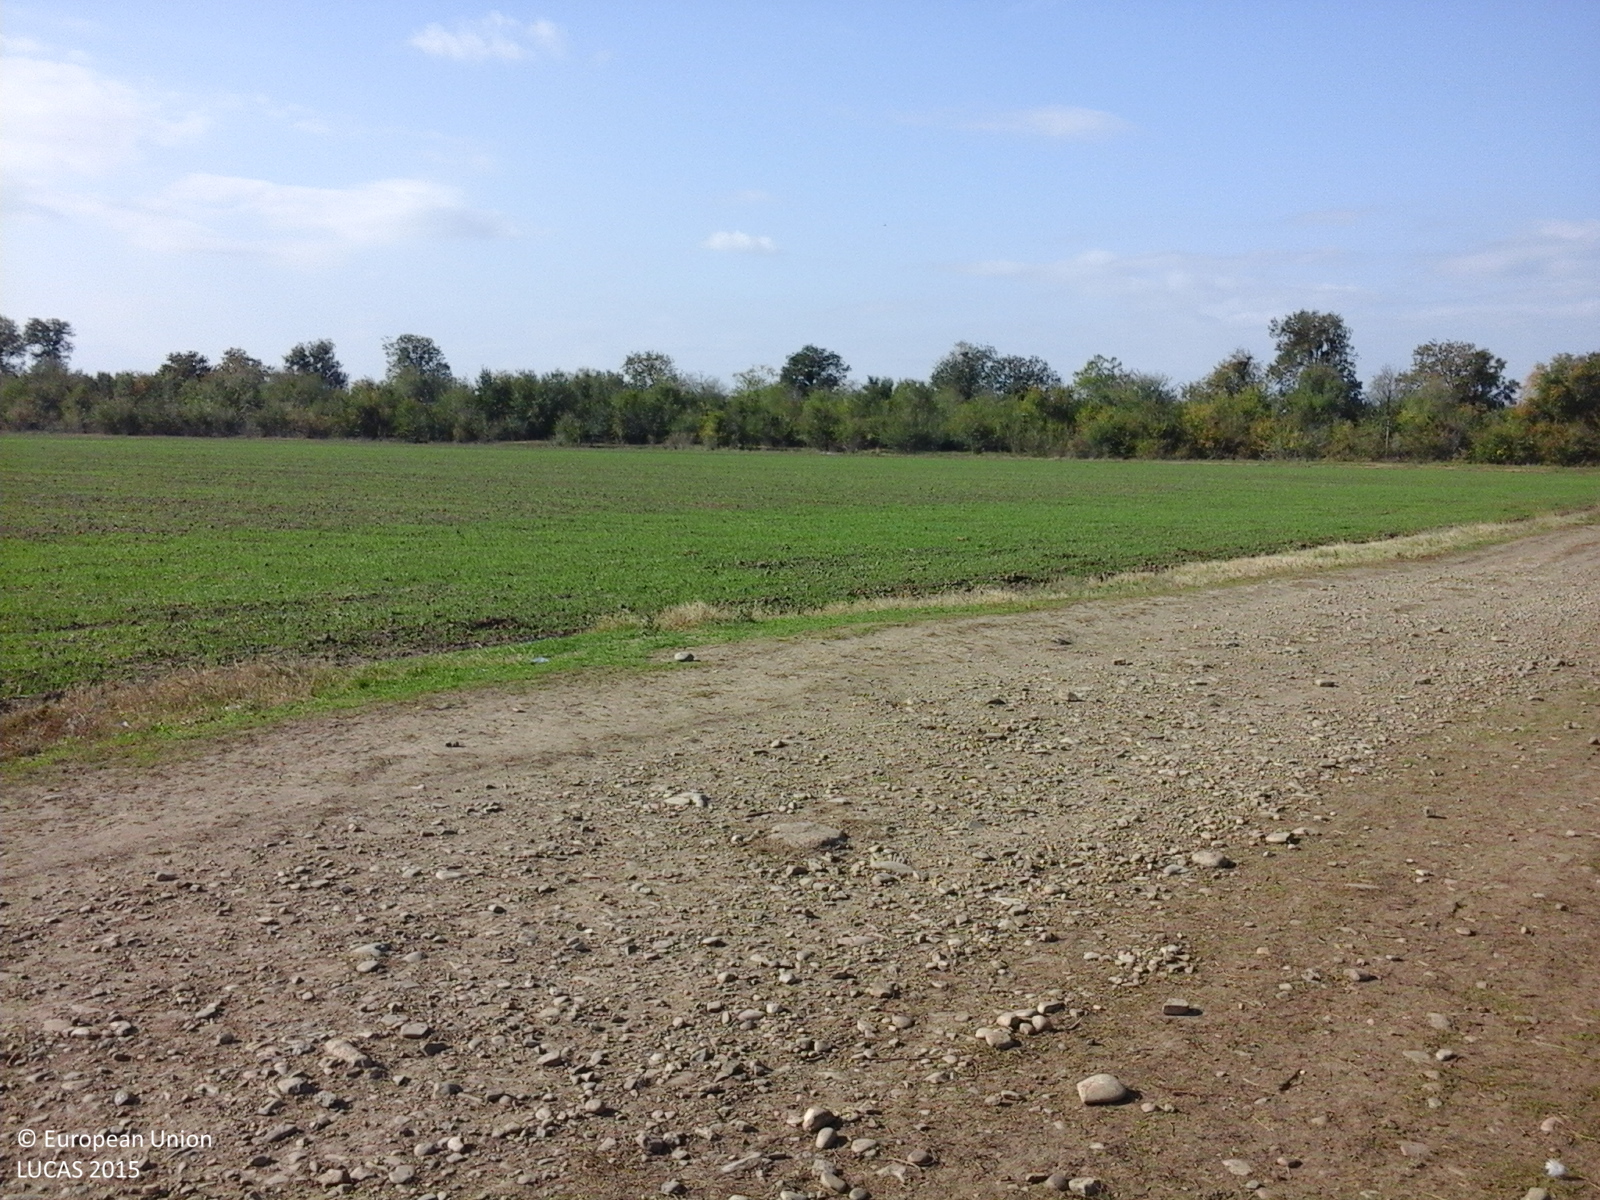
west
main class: Grassland
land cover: Spontaneously vegetated surfaces
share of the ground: > 75 %
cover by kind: herbaceous plants 100 %
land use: Fallow land
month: October
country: RO
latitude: 45.2306
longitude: 27.2494
